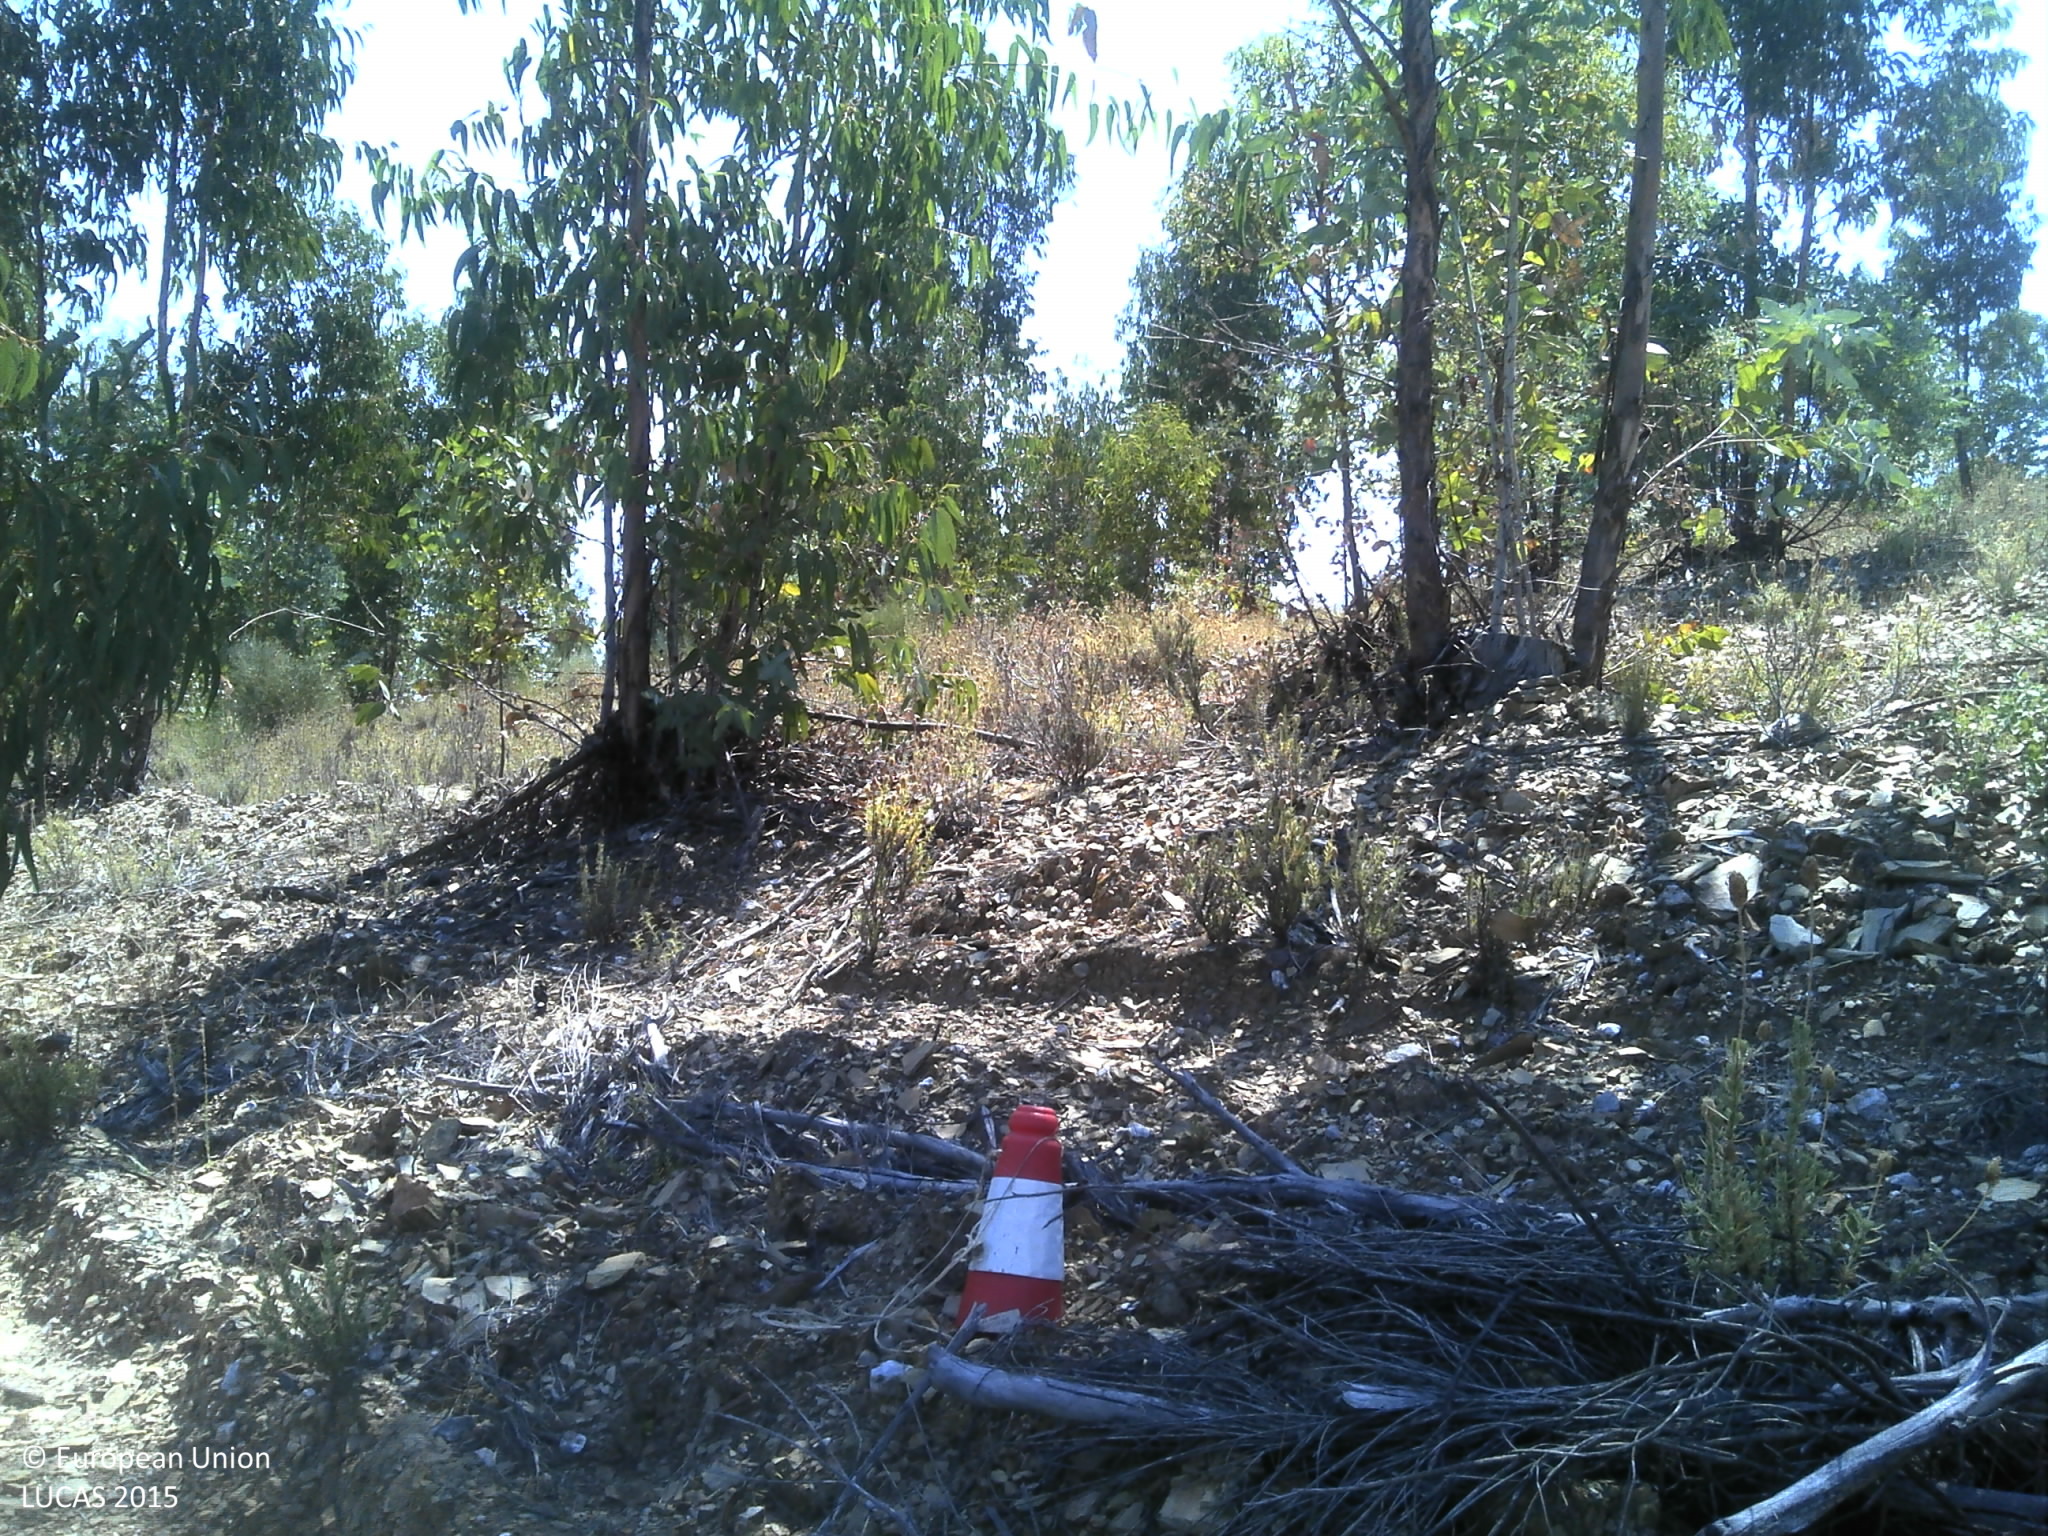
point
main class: Woodland
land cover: Broadleaved woodland
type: exotic forest
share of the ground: 25 - 50 %
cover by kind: broadleaved forest trees 50 %, unconsolidated bare surface 35 %, shrubs 15 %
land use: Forestry
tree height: > 5 m
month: June
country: PT
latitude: 39.7453
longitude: -7.0197
